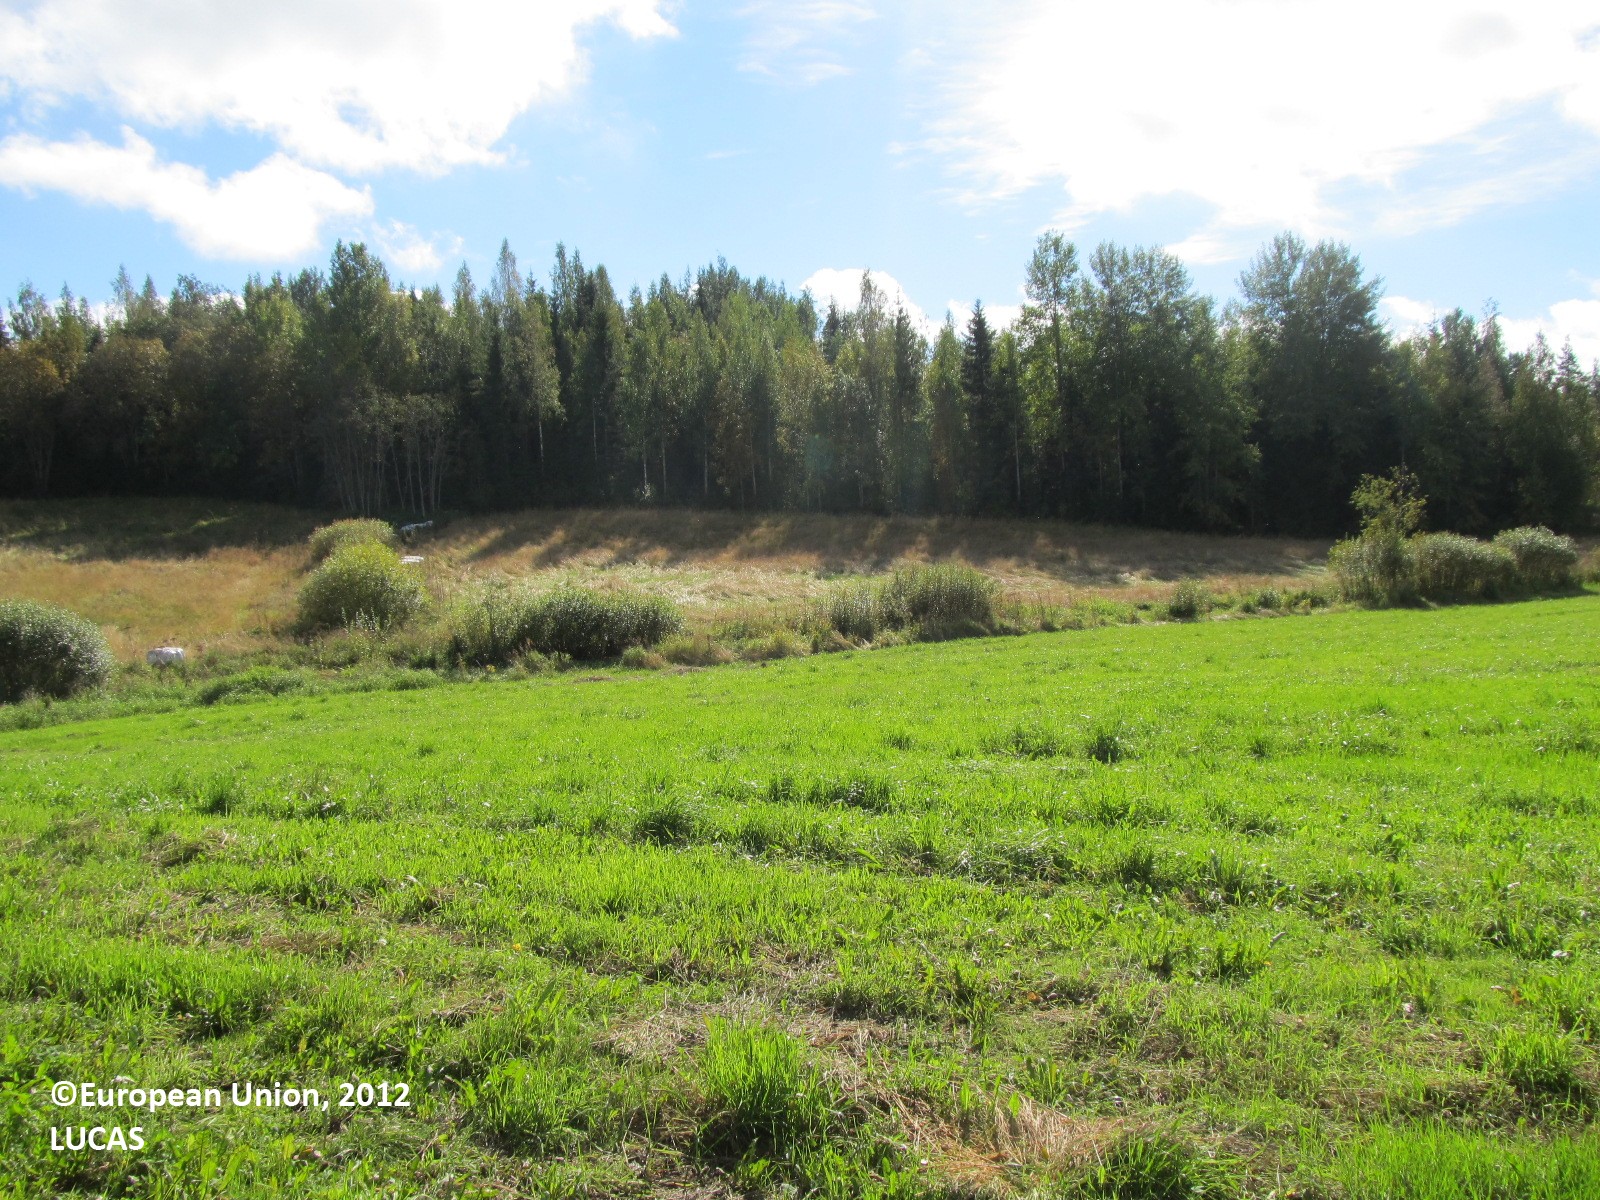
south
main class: Cropland
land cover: Temporary grasslands
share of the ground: 50 - 75 %
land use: Agriculture (excluding fallow land and kitchen gardens)
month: September
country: FI
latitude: 62.9723
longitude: 28.2347
